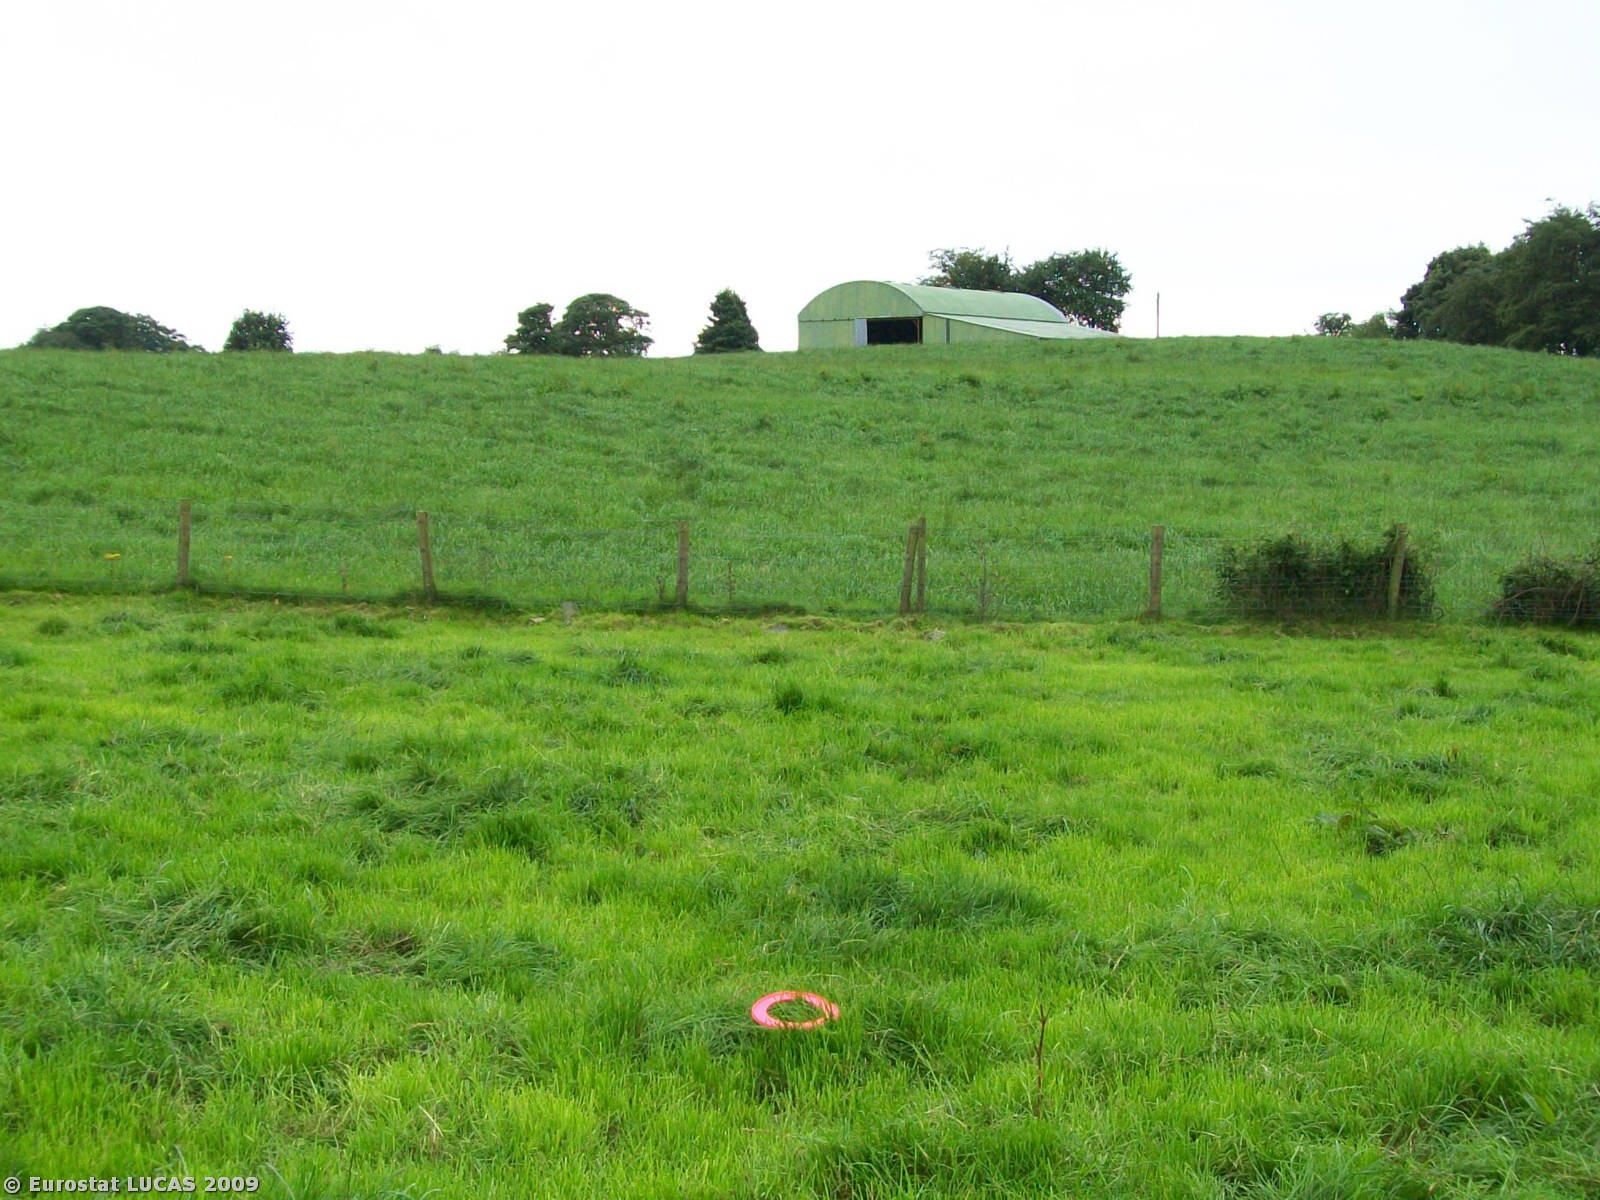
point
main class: Grassland
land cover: Grassland without tree/shrub cover
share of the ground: > 75 %
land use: Agriculture (excluding fallow land and kitchen gardens)
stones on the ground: 10 - 25 %
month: August
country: GB
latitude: 54.1712
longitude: -6.6271
